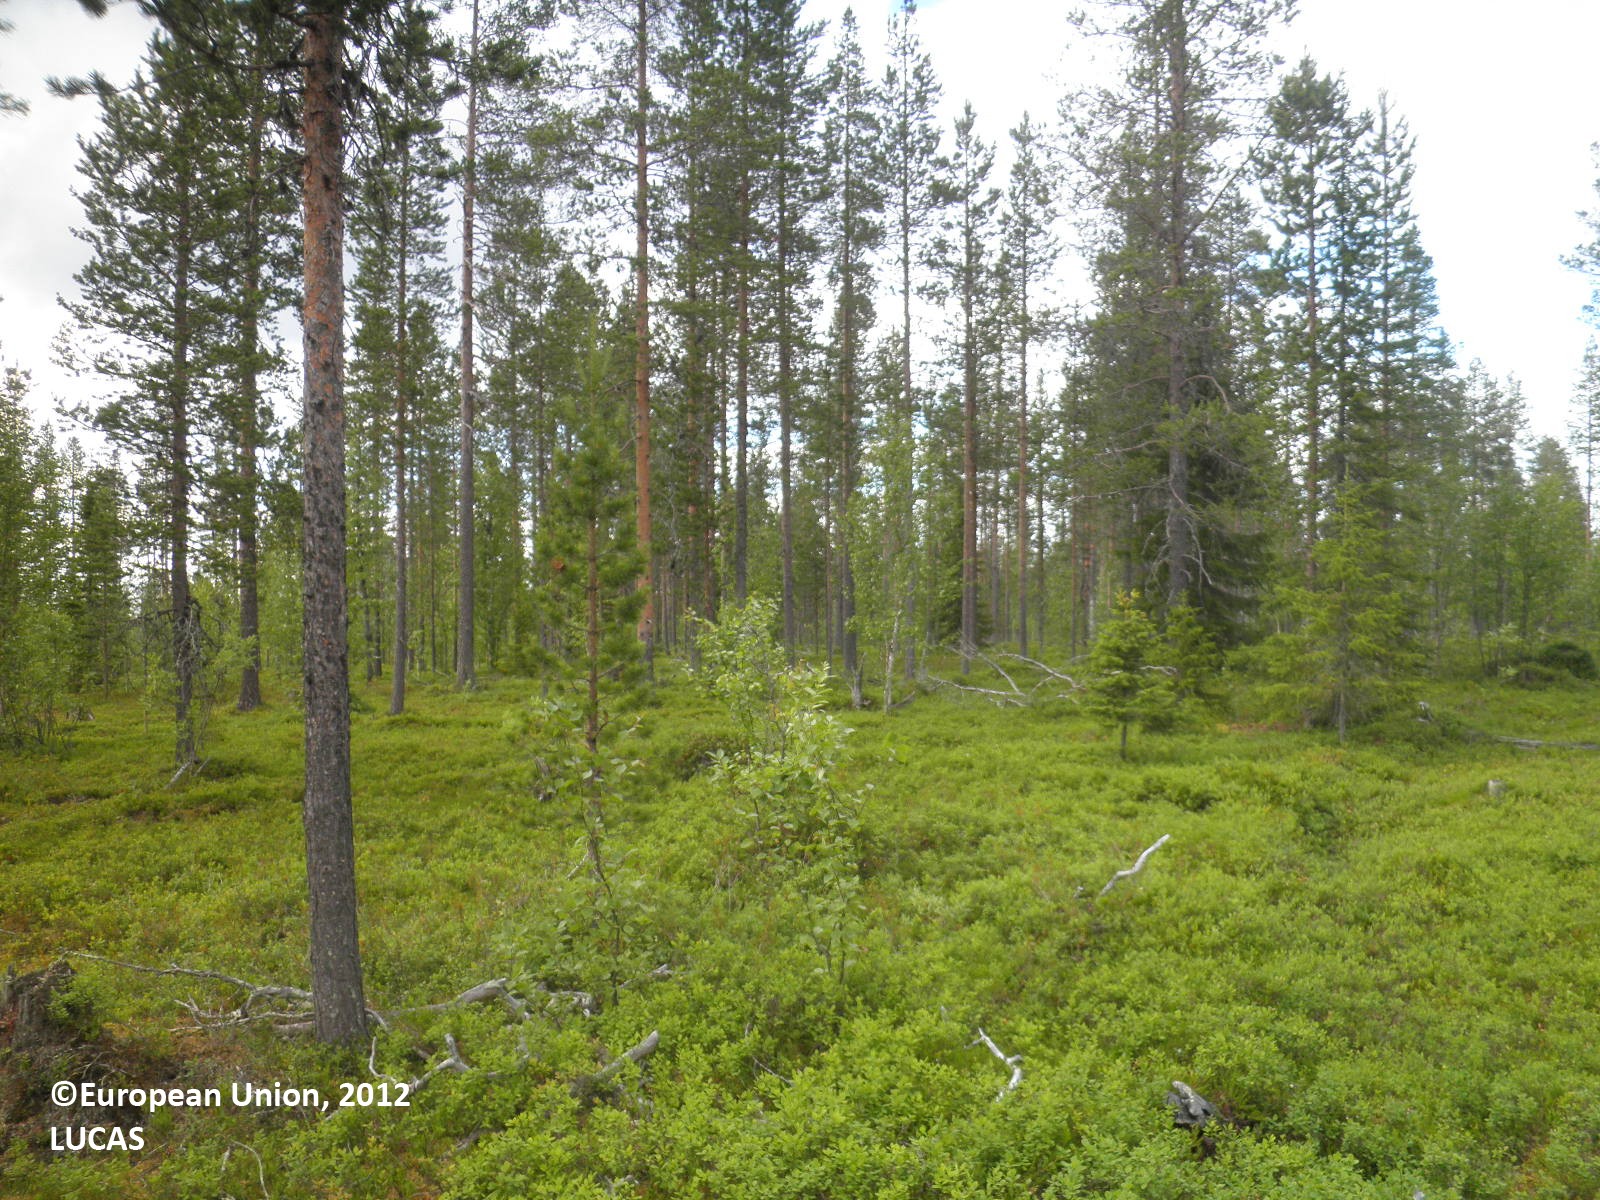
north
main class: Woodland
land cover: Pine dominated mixed woodland
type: boreal forest
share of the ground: 25 - 50 %
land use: Forestry
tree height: > 5 m
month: July
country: FI
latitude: 67.5633
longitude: 26.0490
